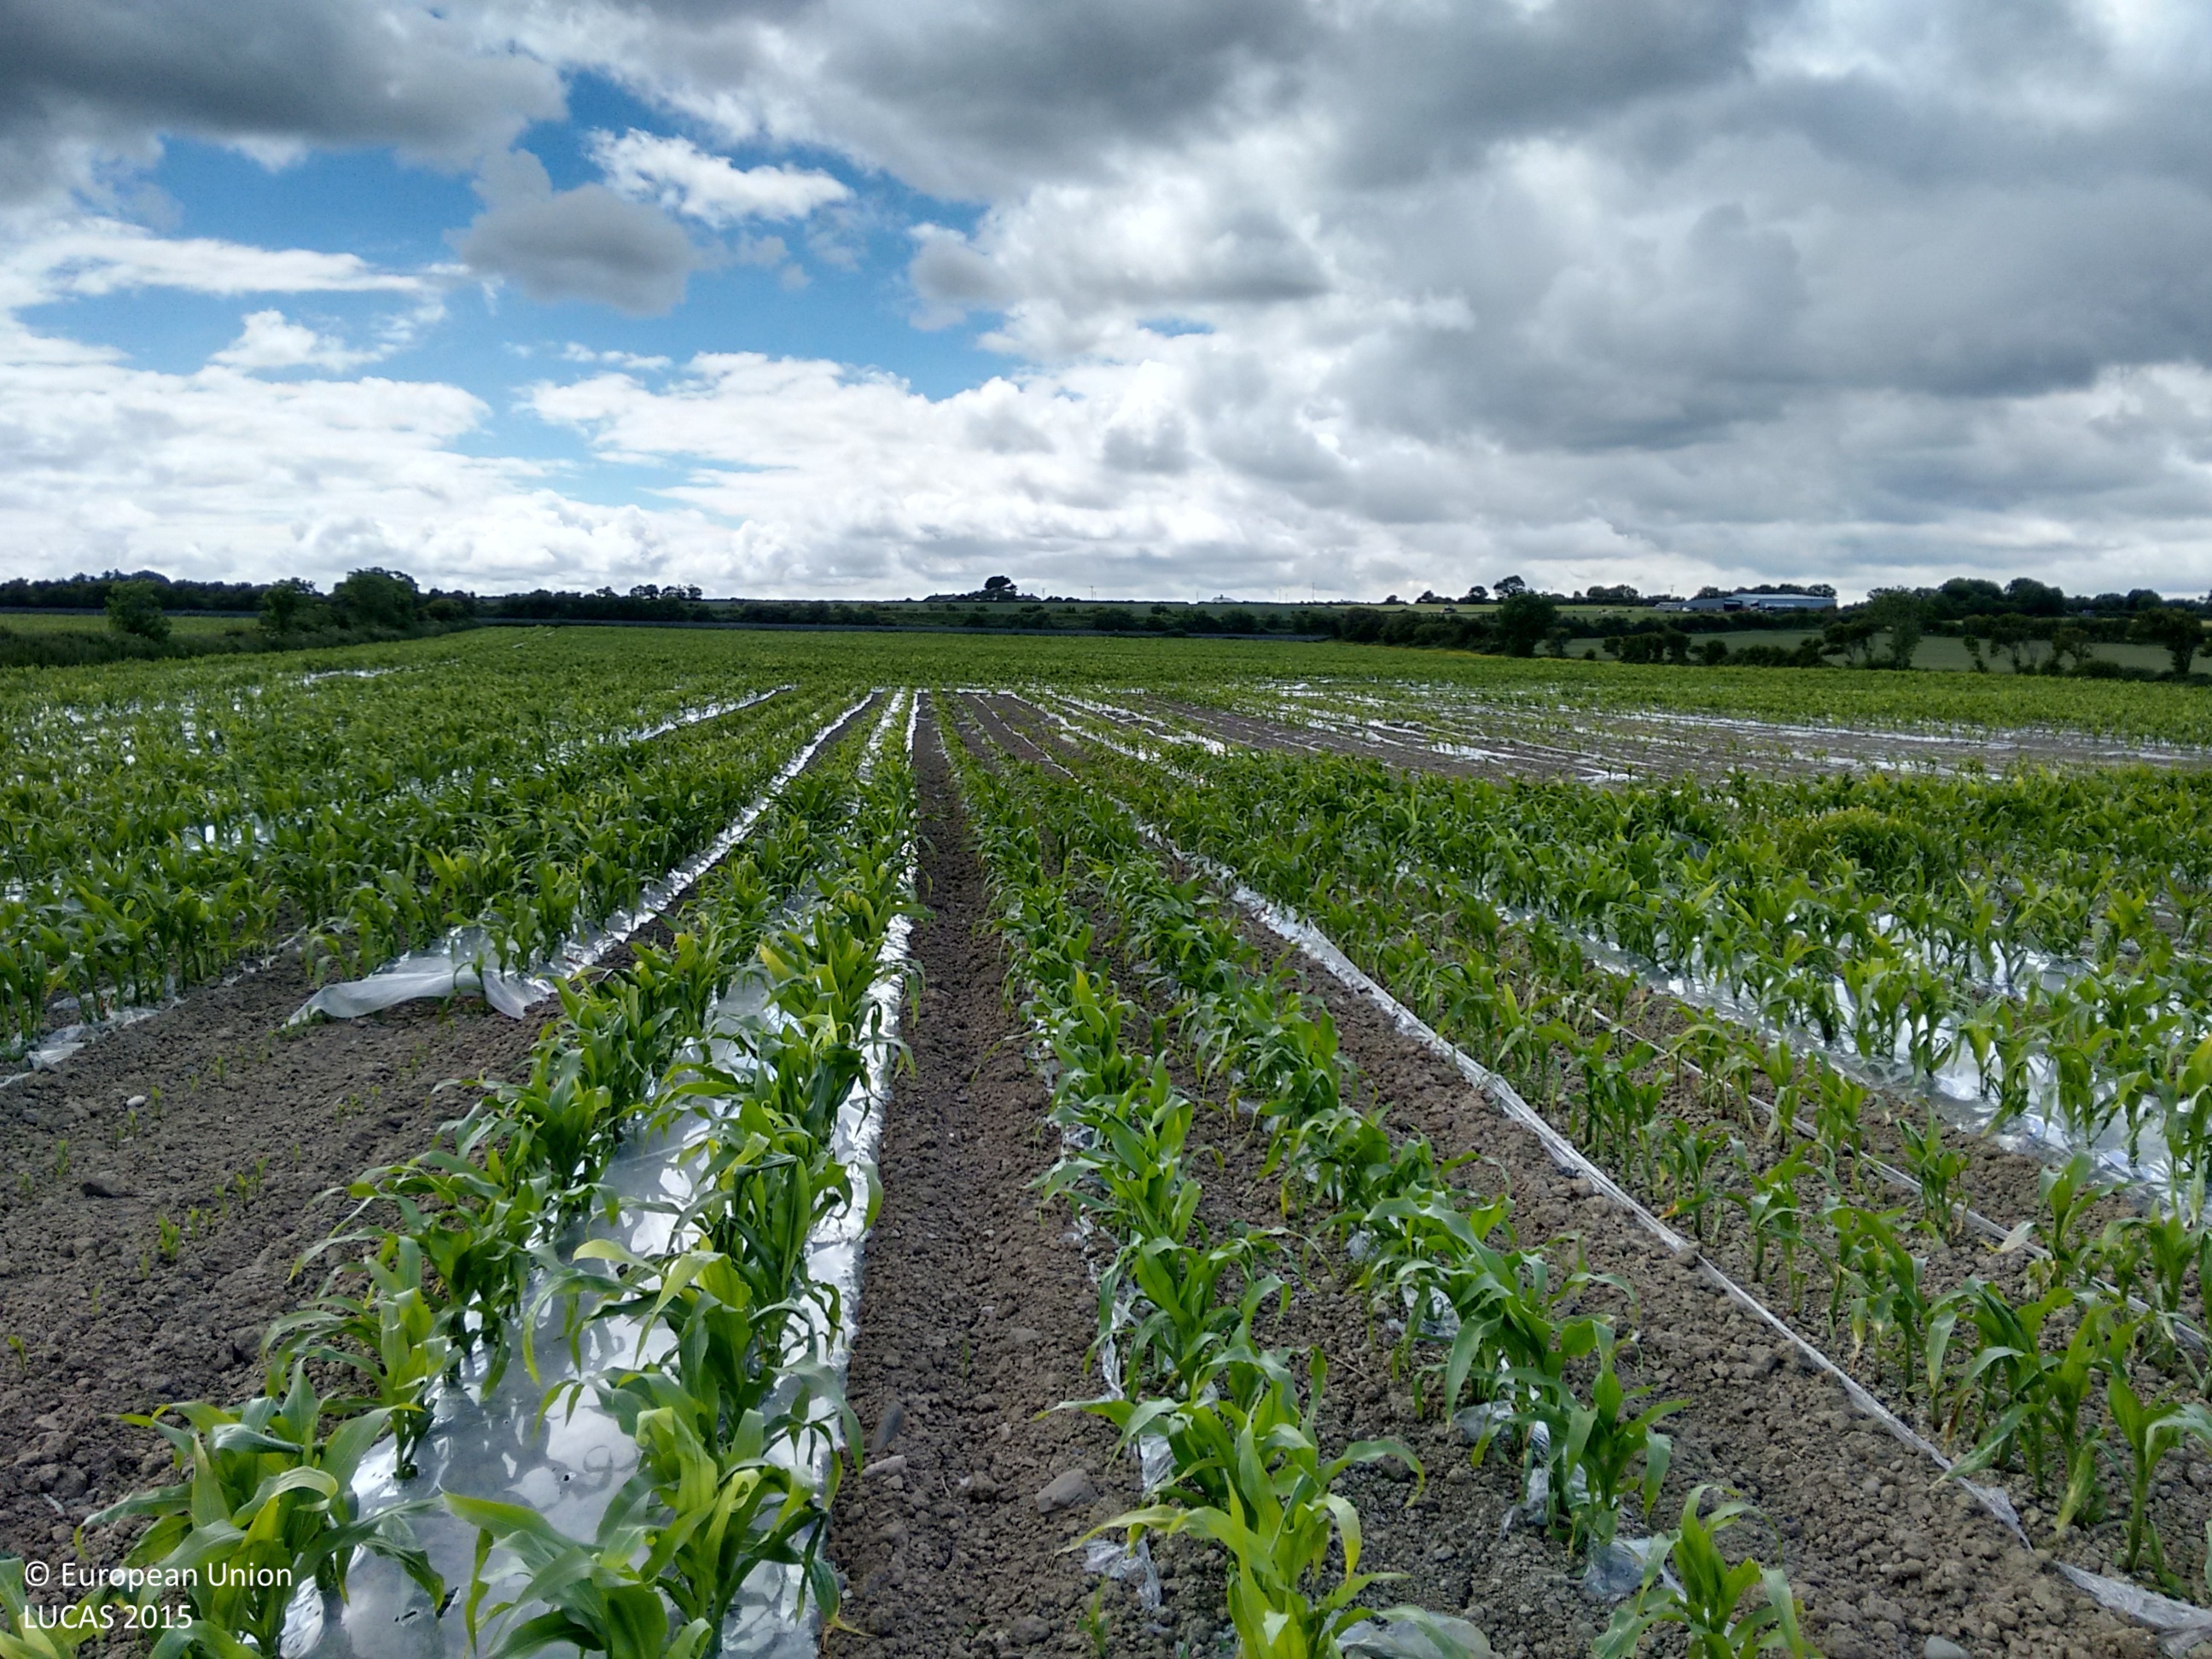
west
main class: Cropland
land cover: Maize
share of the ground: 50 - 75 %
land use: Agriculture (excluding fallow land and kitchen gardens)
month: June
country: IE
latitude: 53.6241
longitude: -6.1896
